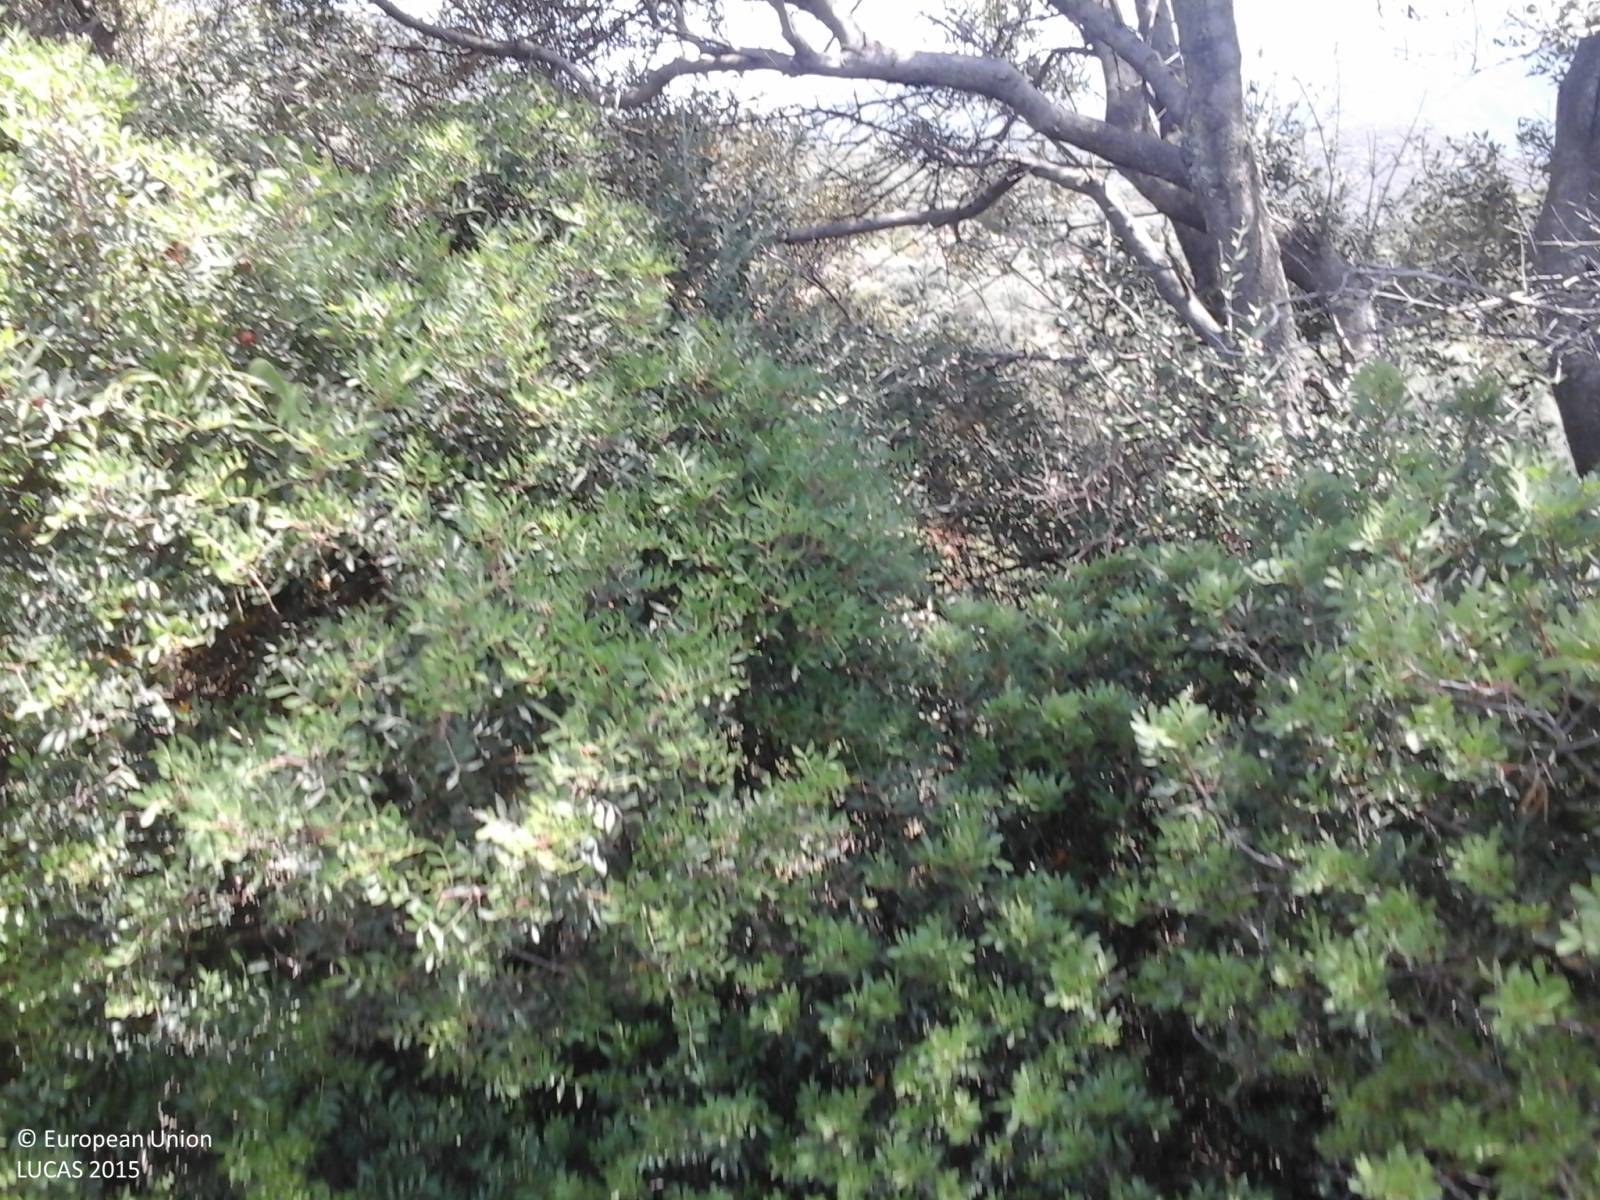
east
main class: Shrubland
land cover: Shrubland without tree cover
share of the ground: 50 - 75 %
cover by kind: shrubs 100 %
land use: Agriculture (excluding fallow land and kitchen gardens)
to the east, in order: Fences; Shrubland with sparse tree cover; Broadleaved woodland; Grassland with sparse tree/shrub cover; Abandoned hedges; Grassland with sparse tree/shrub cover
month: July
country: IT
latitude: 39.4410
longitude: 8.5100
